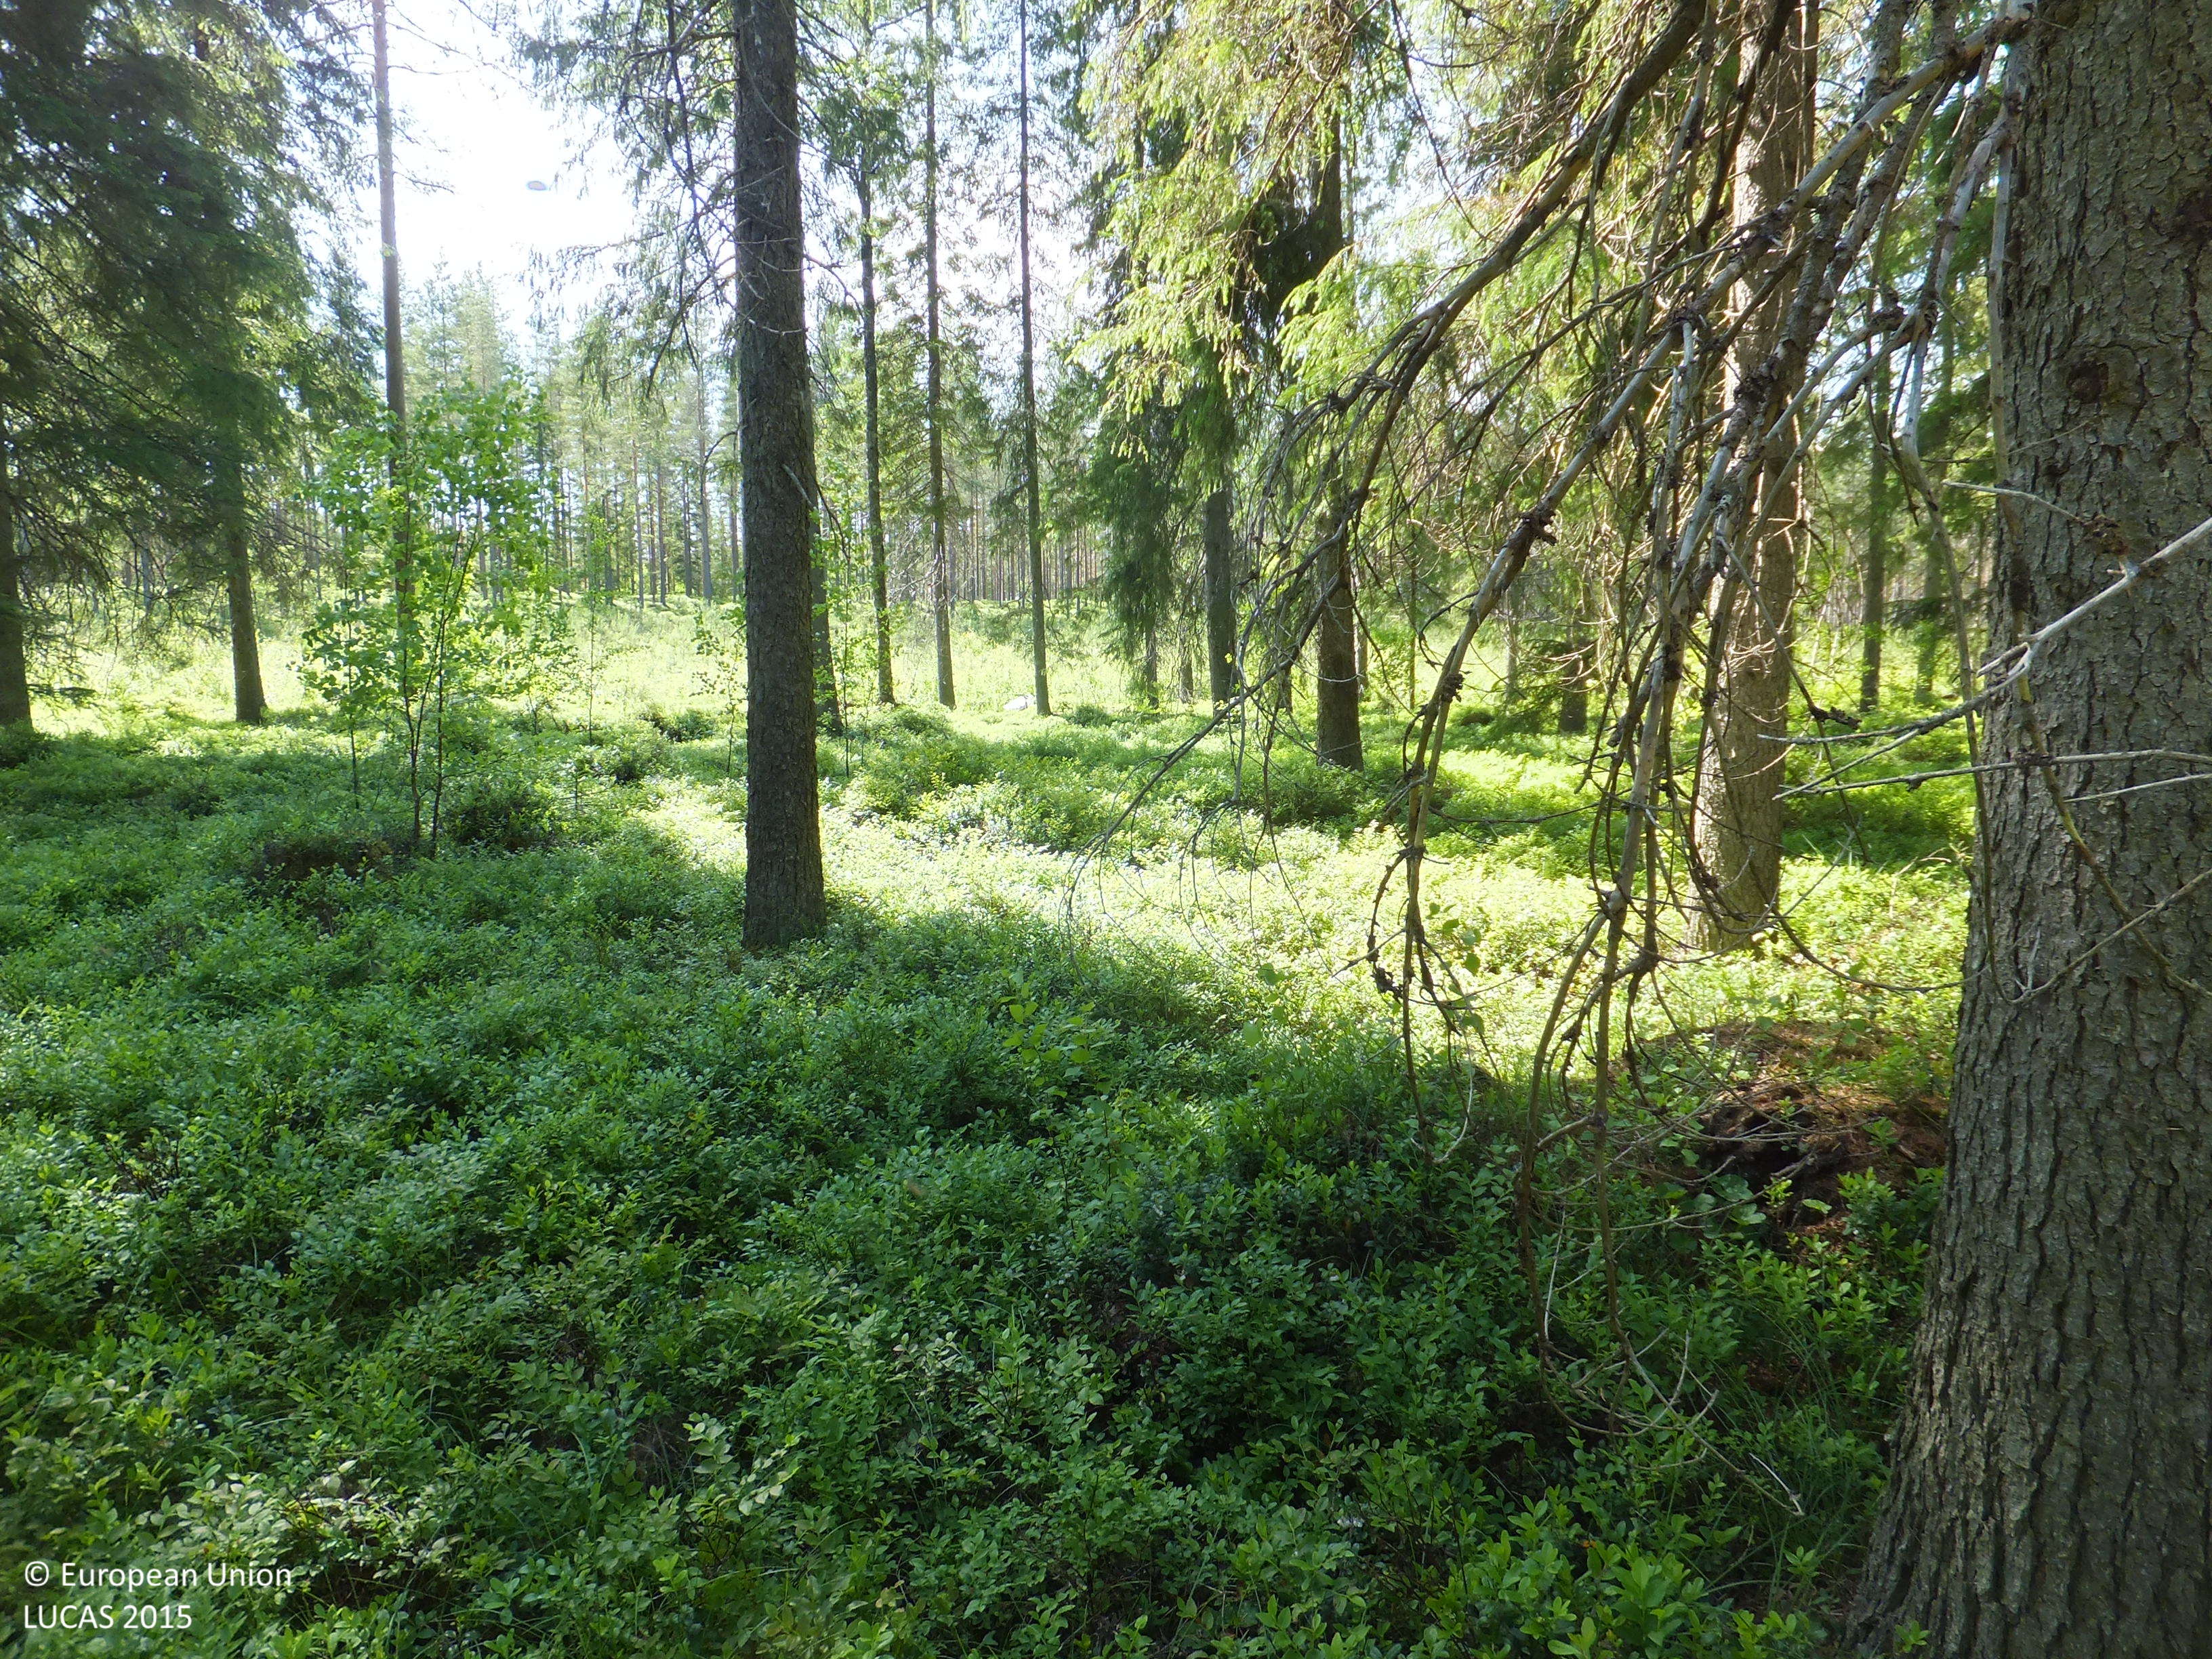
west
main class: Woodland
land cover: Spruce dominated coniferous woodland
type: boreal forest
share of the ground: > 75 %
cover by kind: coniferous forest trees 75 %, shrubs 15 %, broadleaved forest trees 5 %, lichens and mosses 5 %
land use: Forestry
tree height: > 5 m
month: July
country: FI
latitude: 63.0188
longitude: 24.2048
